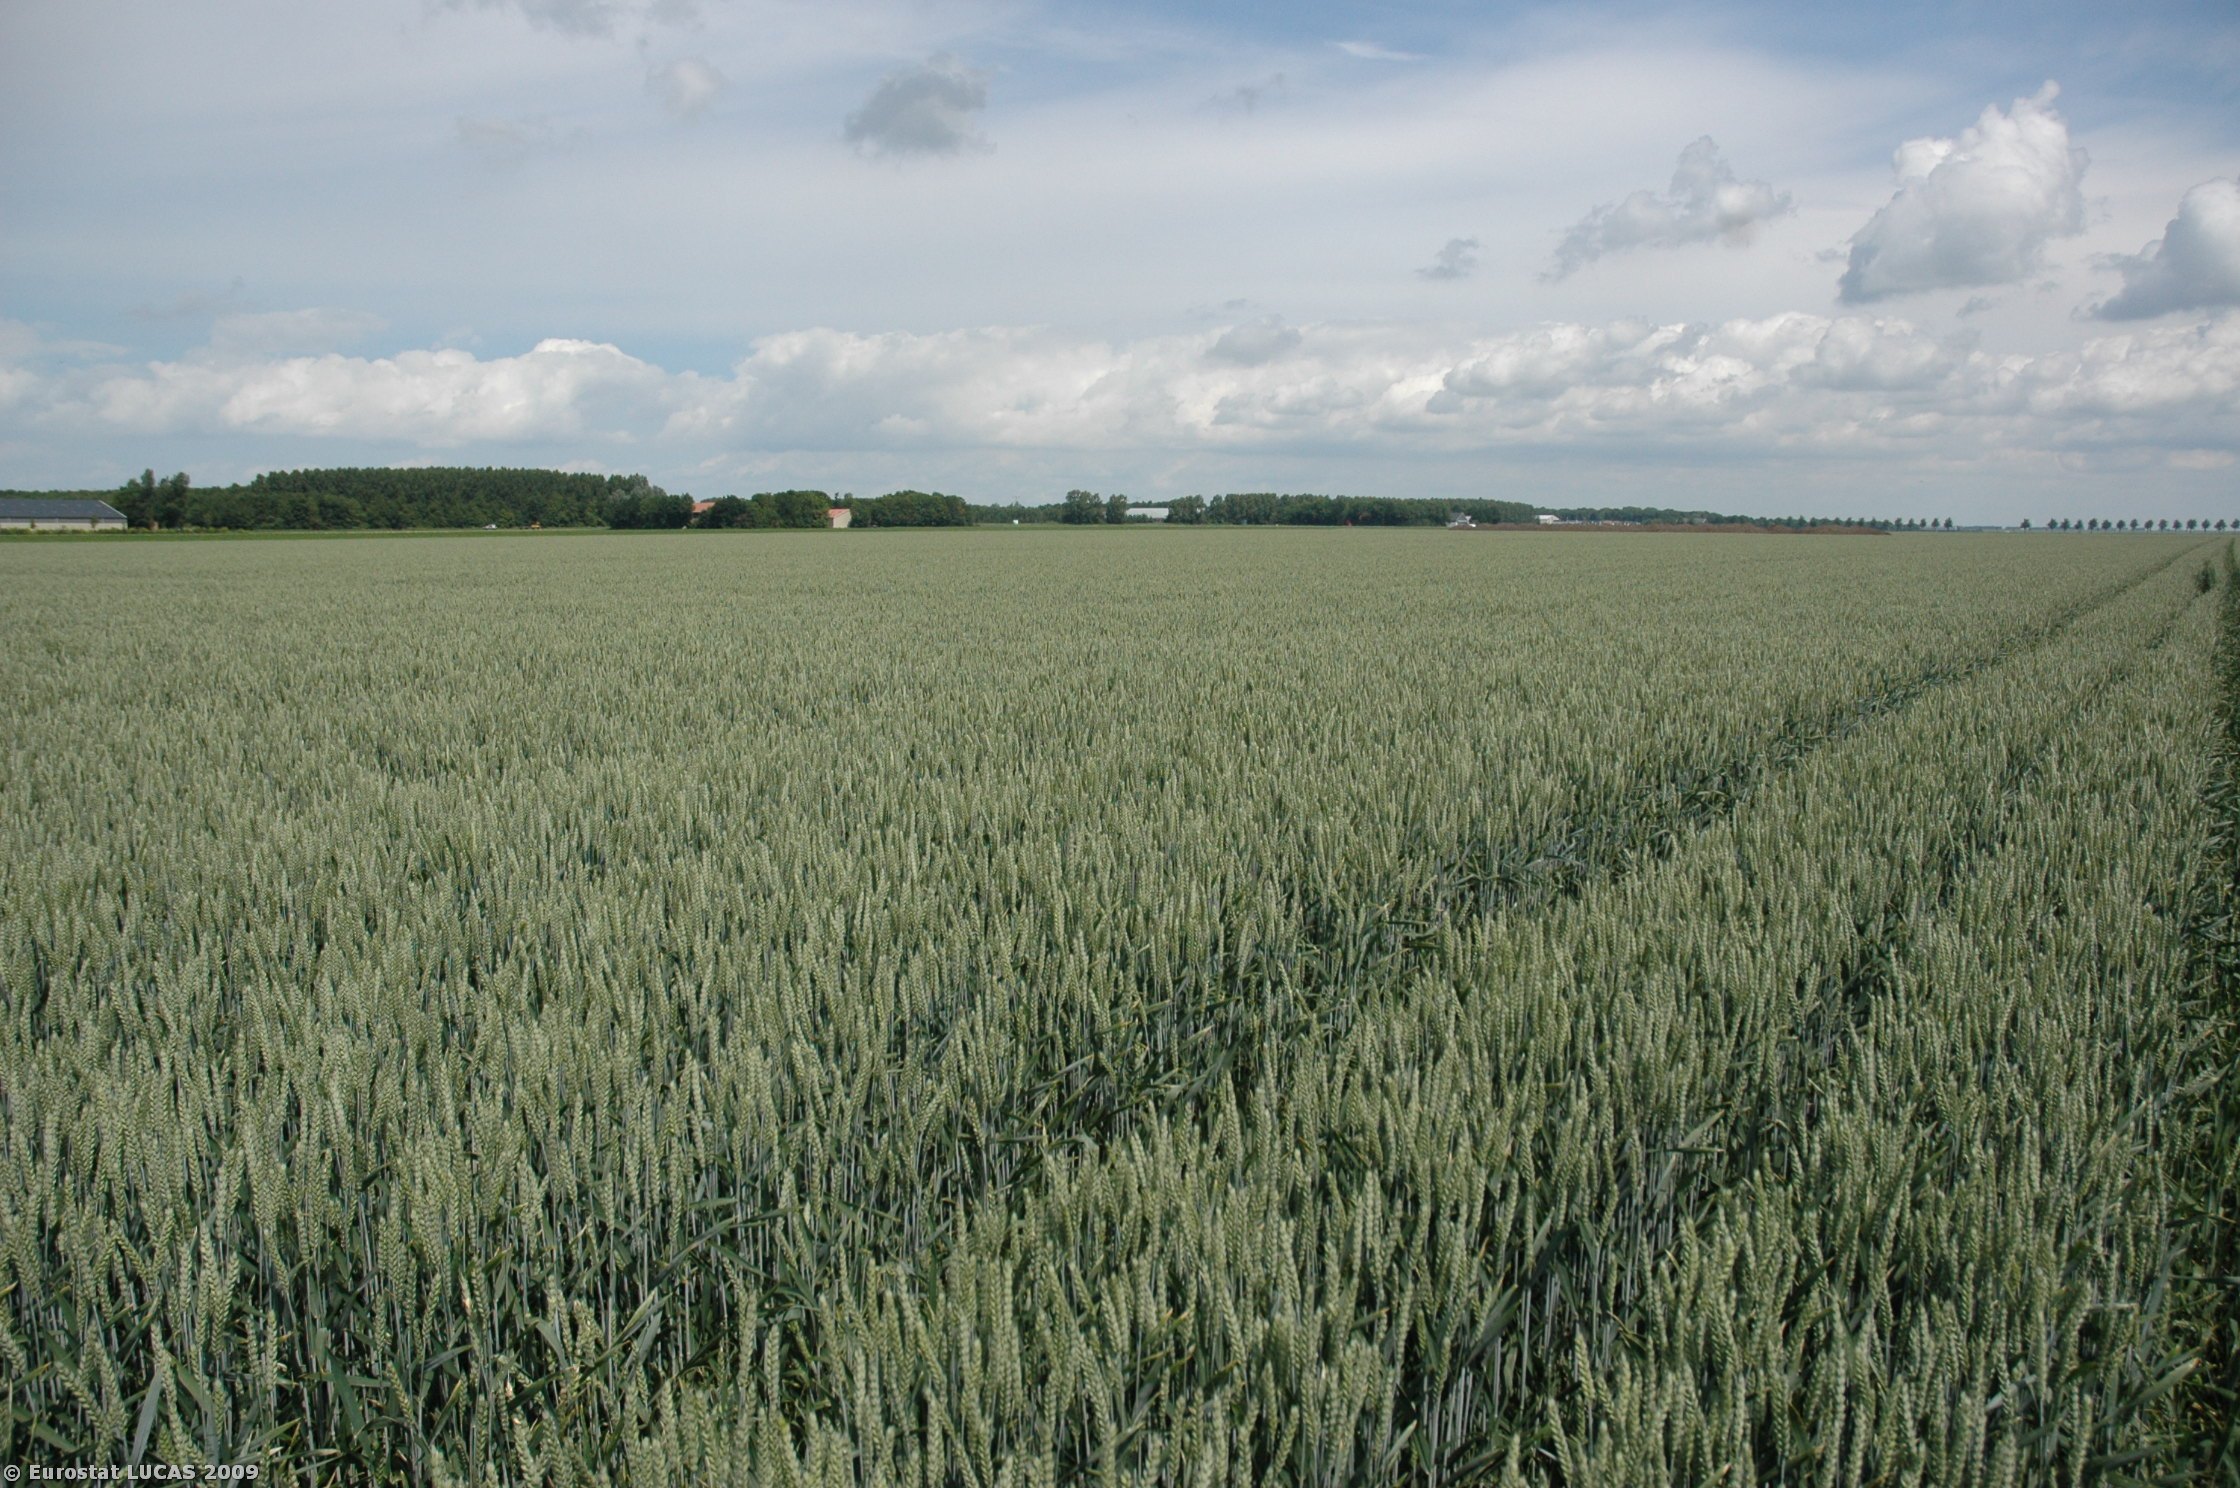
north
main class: Cropland
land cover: Common wheat
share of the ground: > 75 %
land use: Agriculture (excluding fallow land and kitchen gardens)
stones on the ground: < 10 %
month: June
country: NL
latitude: 52.5498
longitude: 5.6482
